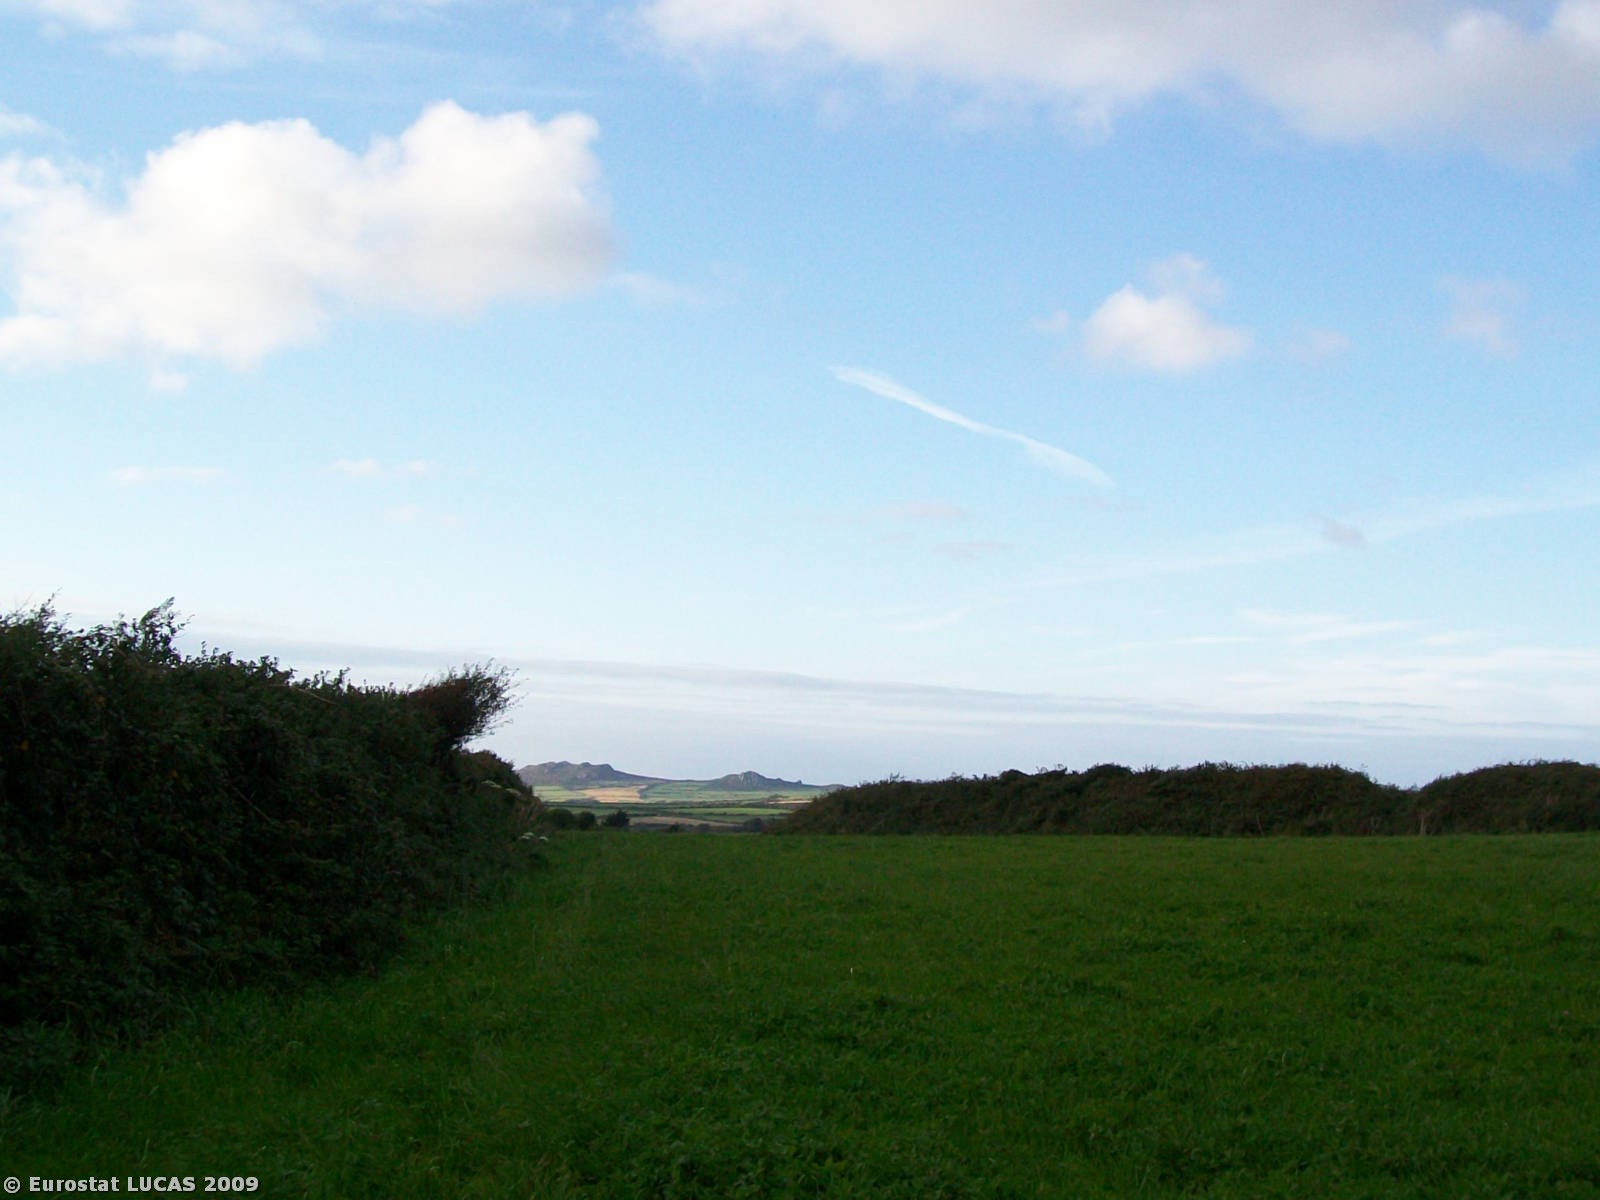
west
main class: Grassland
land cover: Grassland without tree/shrub cover
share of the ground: > 75 %
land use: Agriculture (excluding fallow land and kitchen gardens)
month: September
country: GB
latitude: 51.9613
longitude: -5.0351
